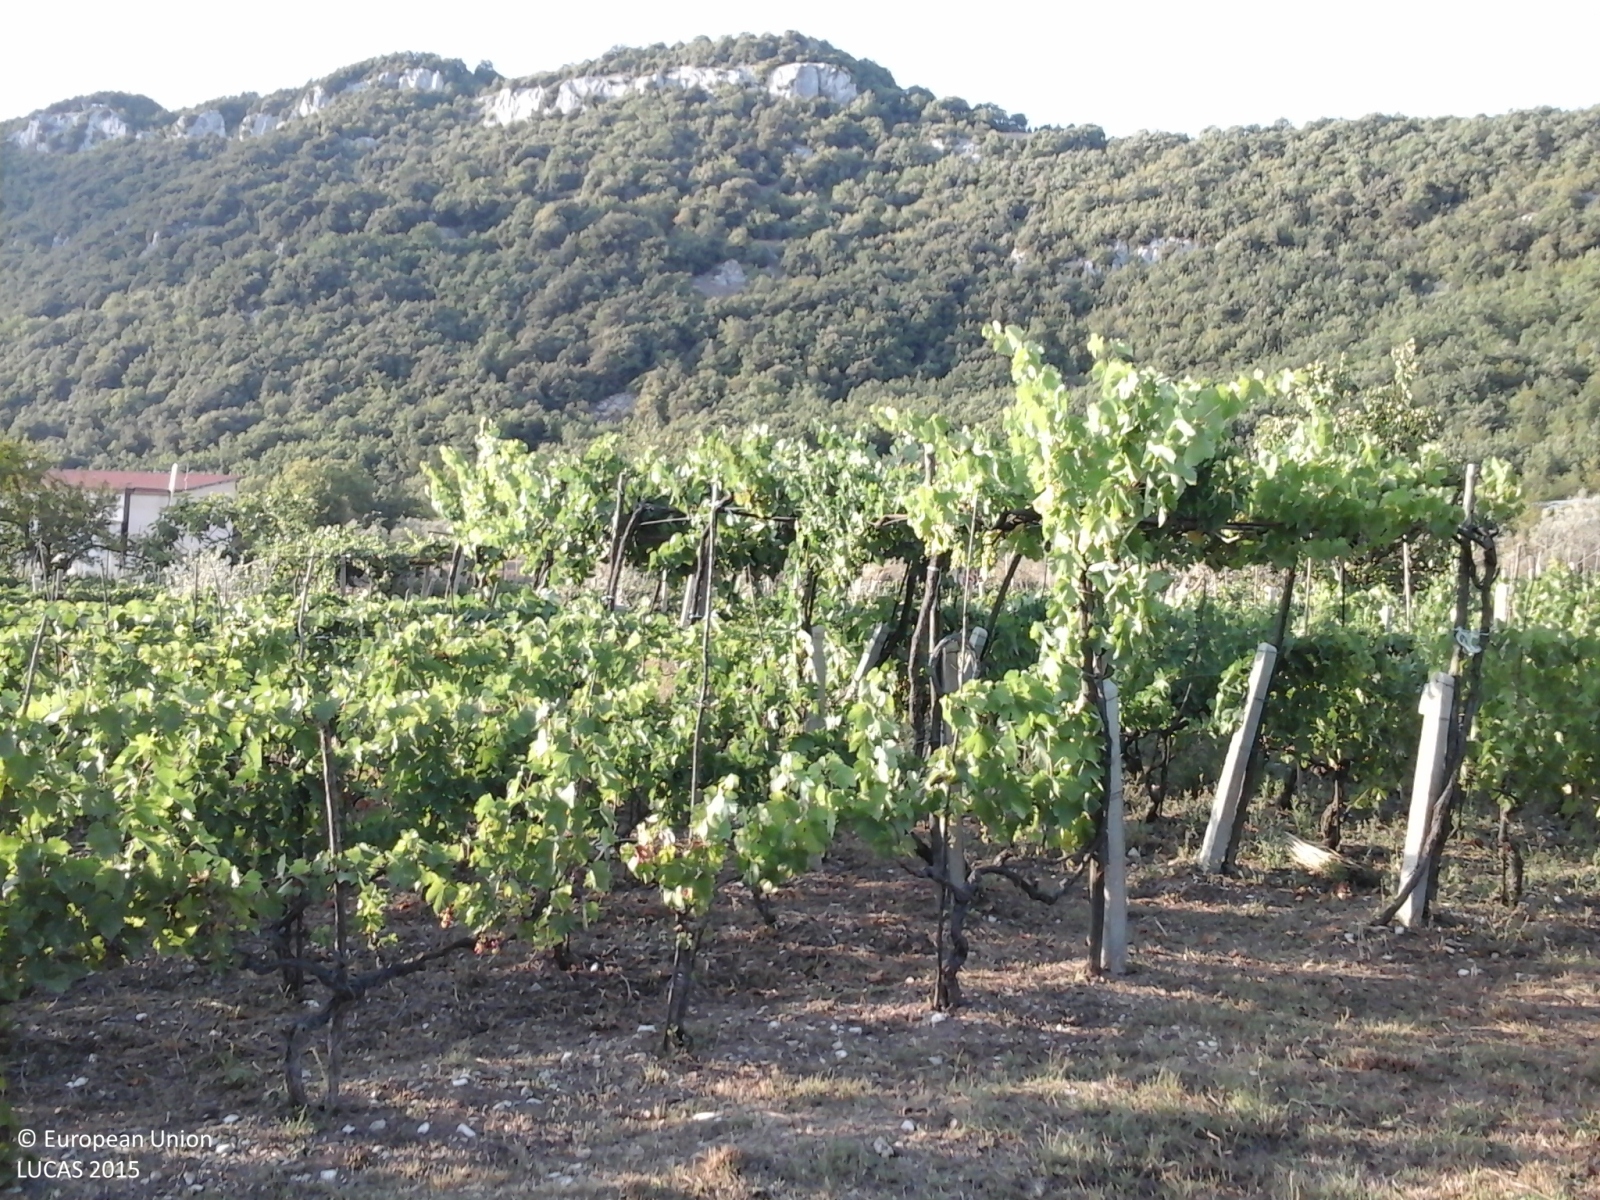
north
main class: Shrubland
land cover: Shrubland with sparse tree cover
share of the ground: > 75 %
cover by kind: shrubs 90 %, broadleaved forest trees 5 %, herbaceous plants 5 %
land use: Semi-natural and natural areas not in use
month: August
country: IT
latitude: 41.6042
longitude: 14.2923
